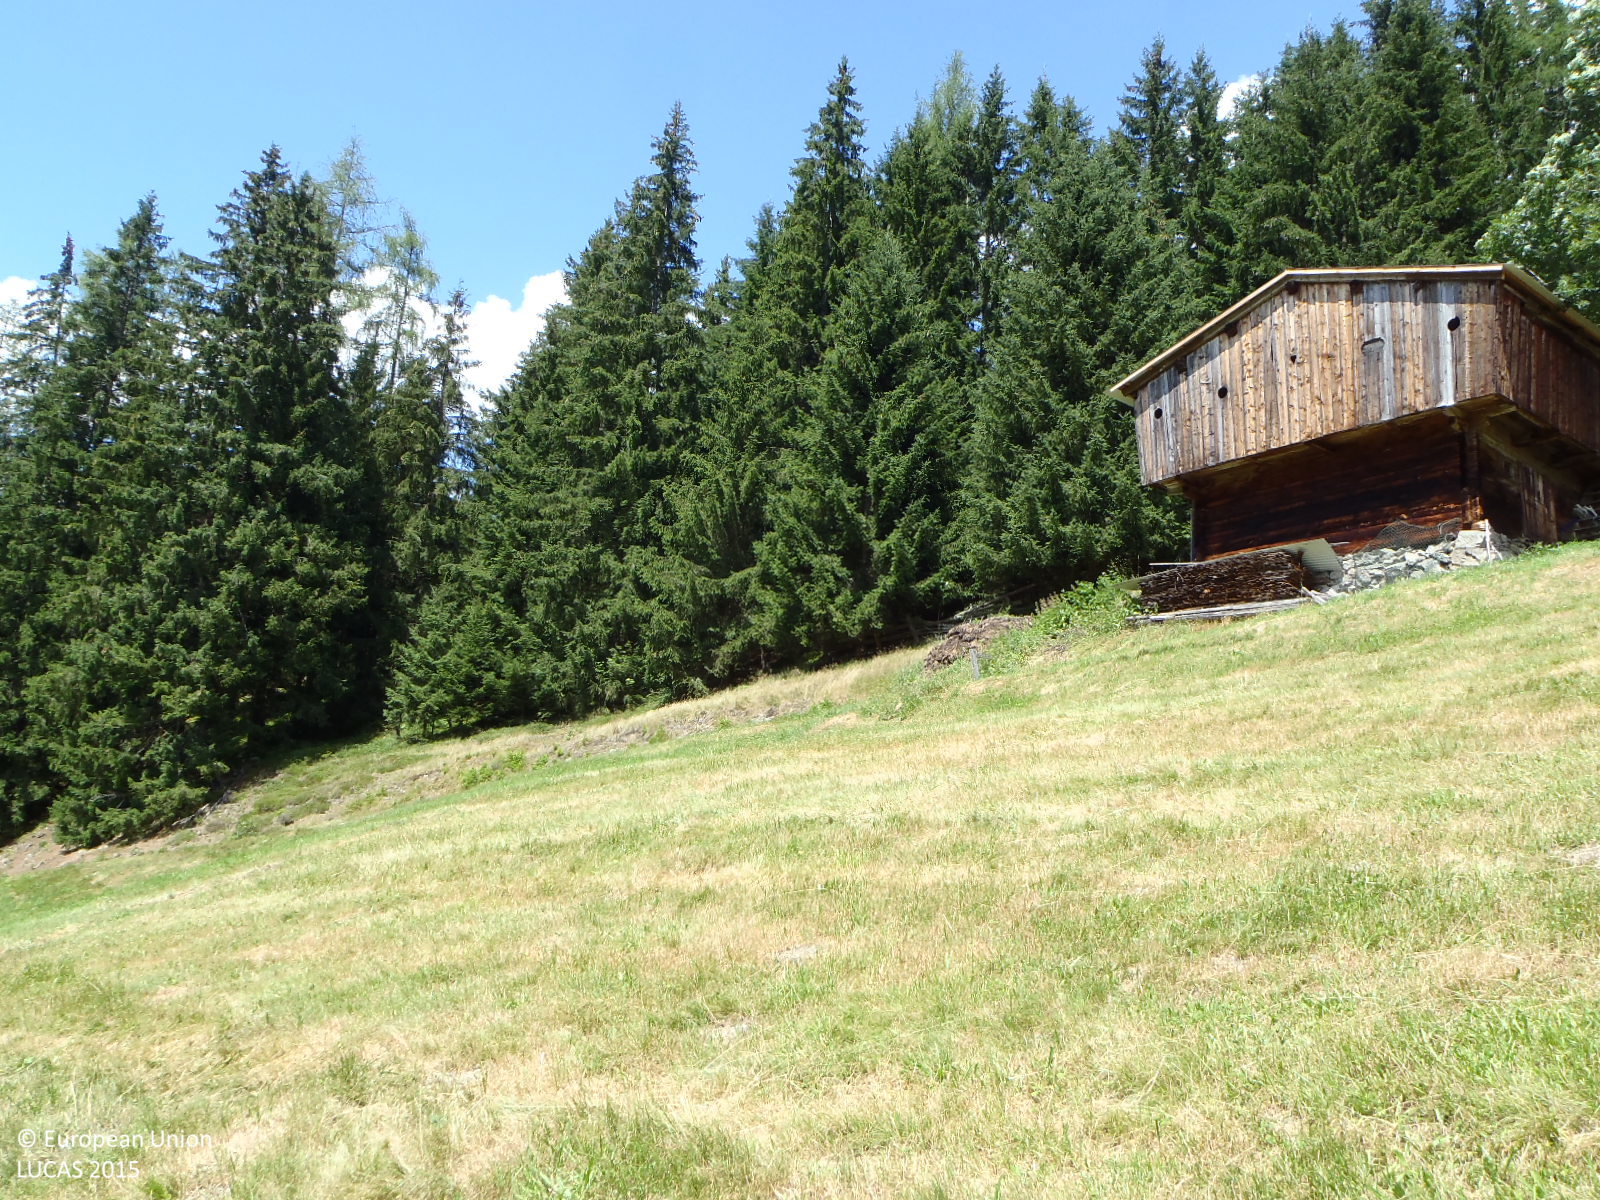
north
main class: Grassland
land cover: Grassland without tree/shrub cover
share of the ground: > 75 %
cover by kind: herbaceous plants 100 %
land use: Agriculture (excluding fallow land and kitchen gardens)
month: July
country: AT
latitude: 47.3777
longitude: 11.9719
